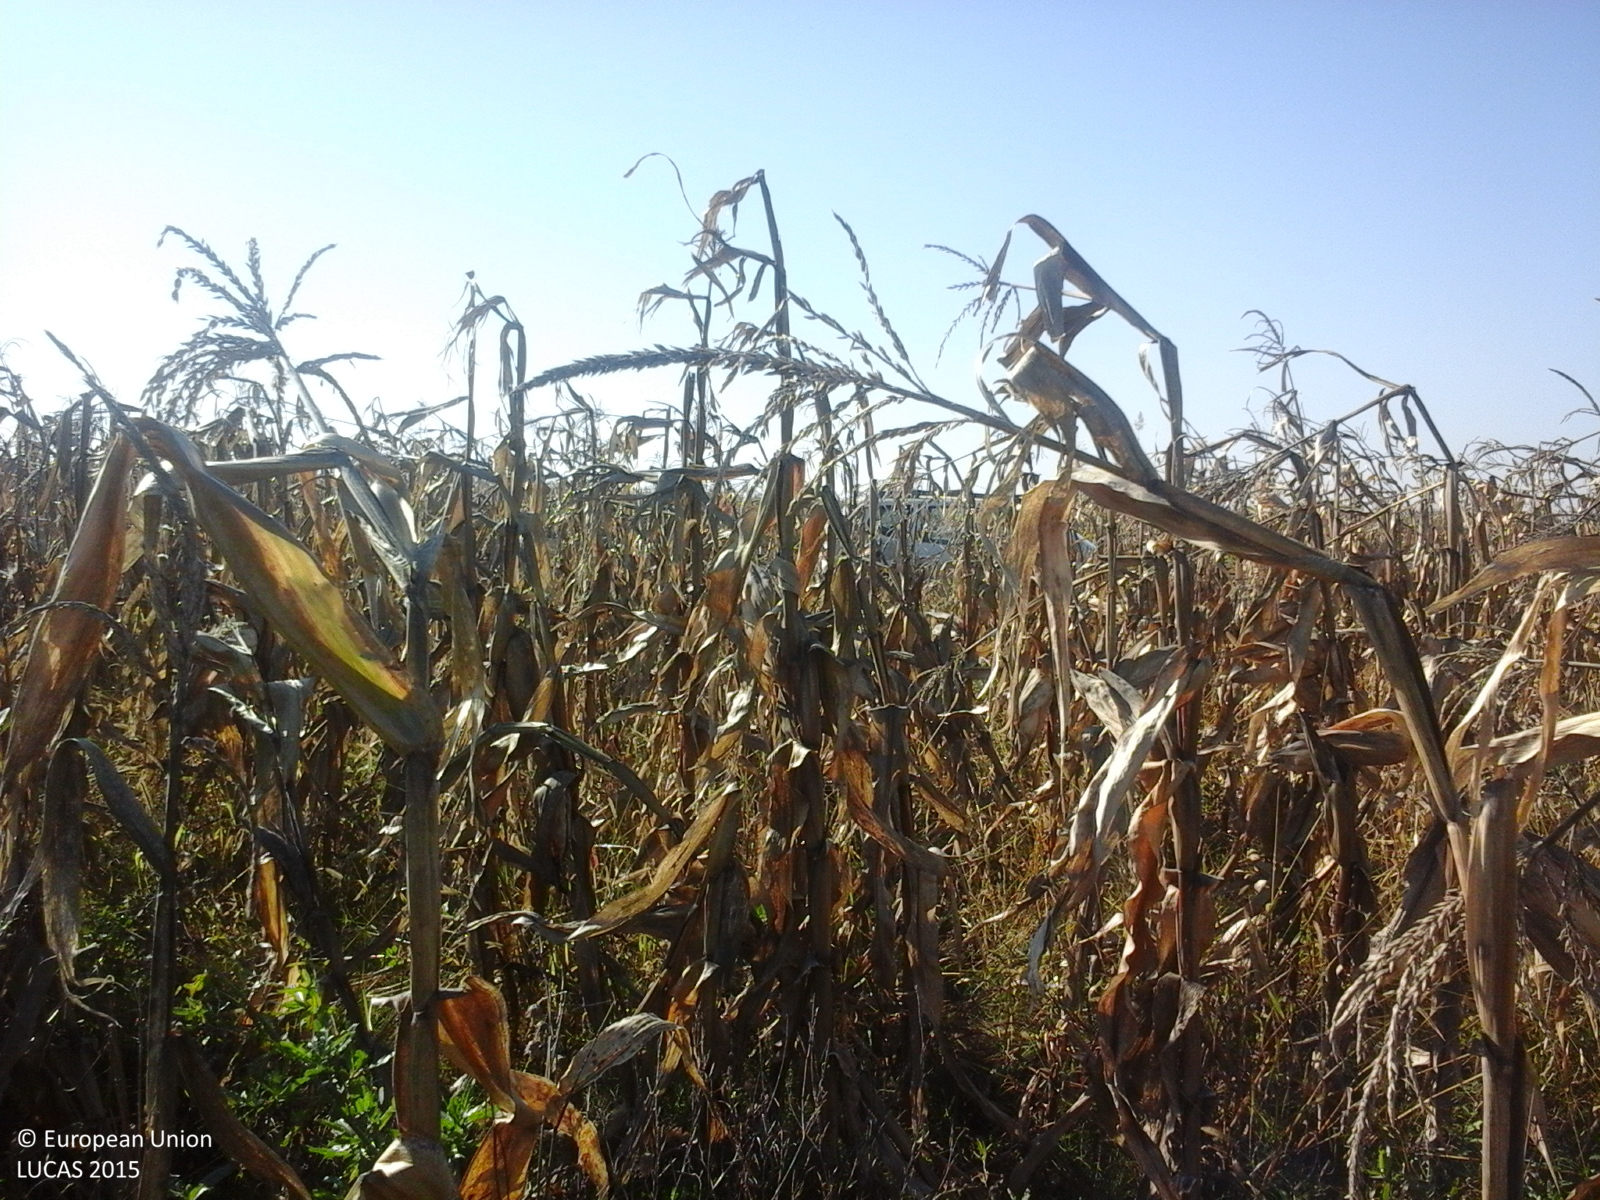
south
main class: Cropland
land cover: Maize
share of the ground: > 75 %
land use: Agriculture (excluding fallow land and kitchen gardens)
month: October
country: RO
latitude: 45.6456
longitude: 27.4096
